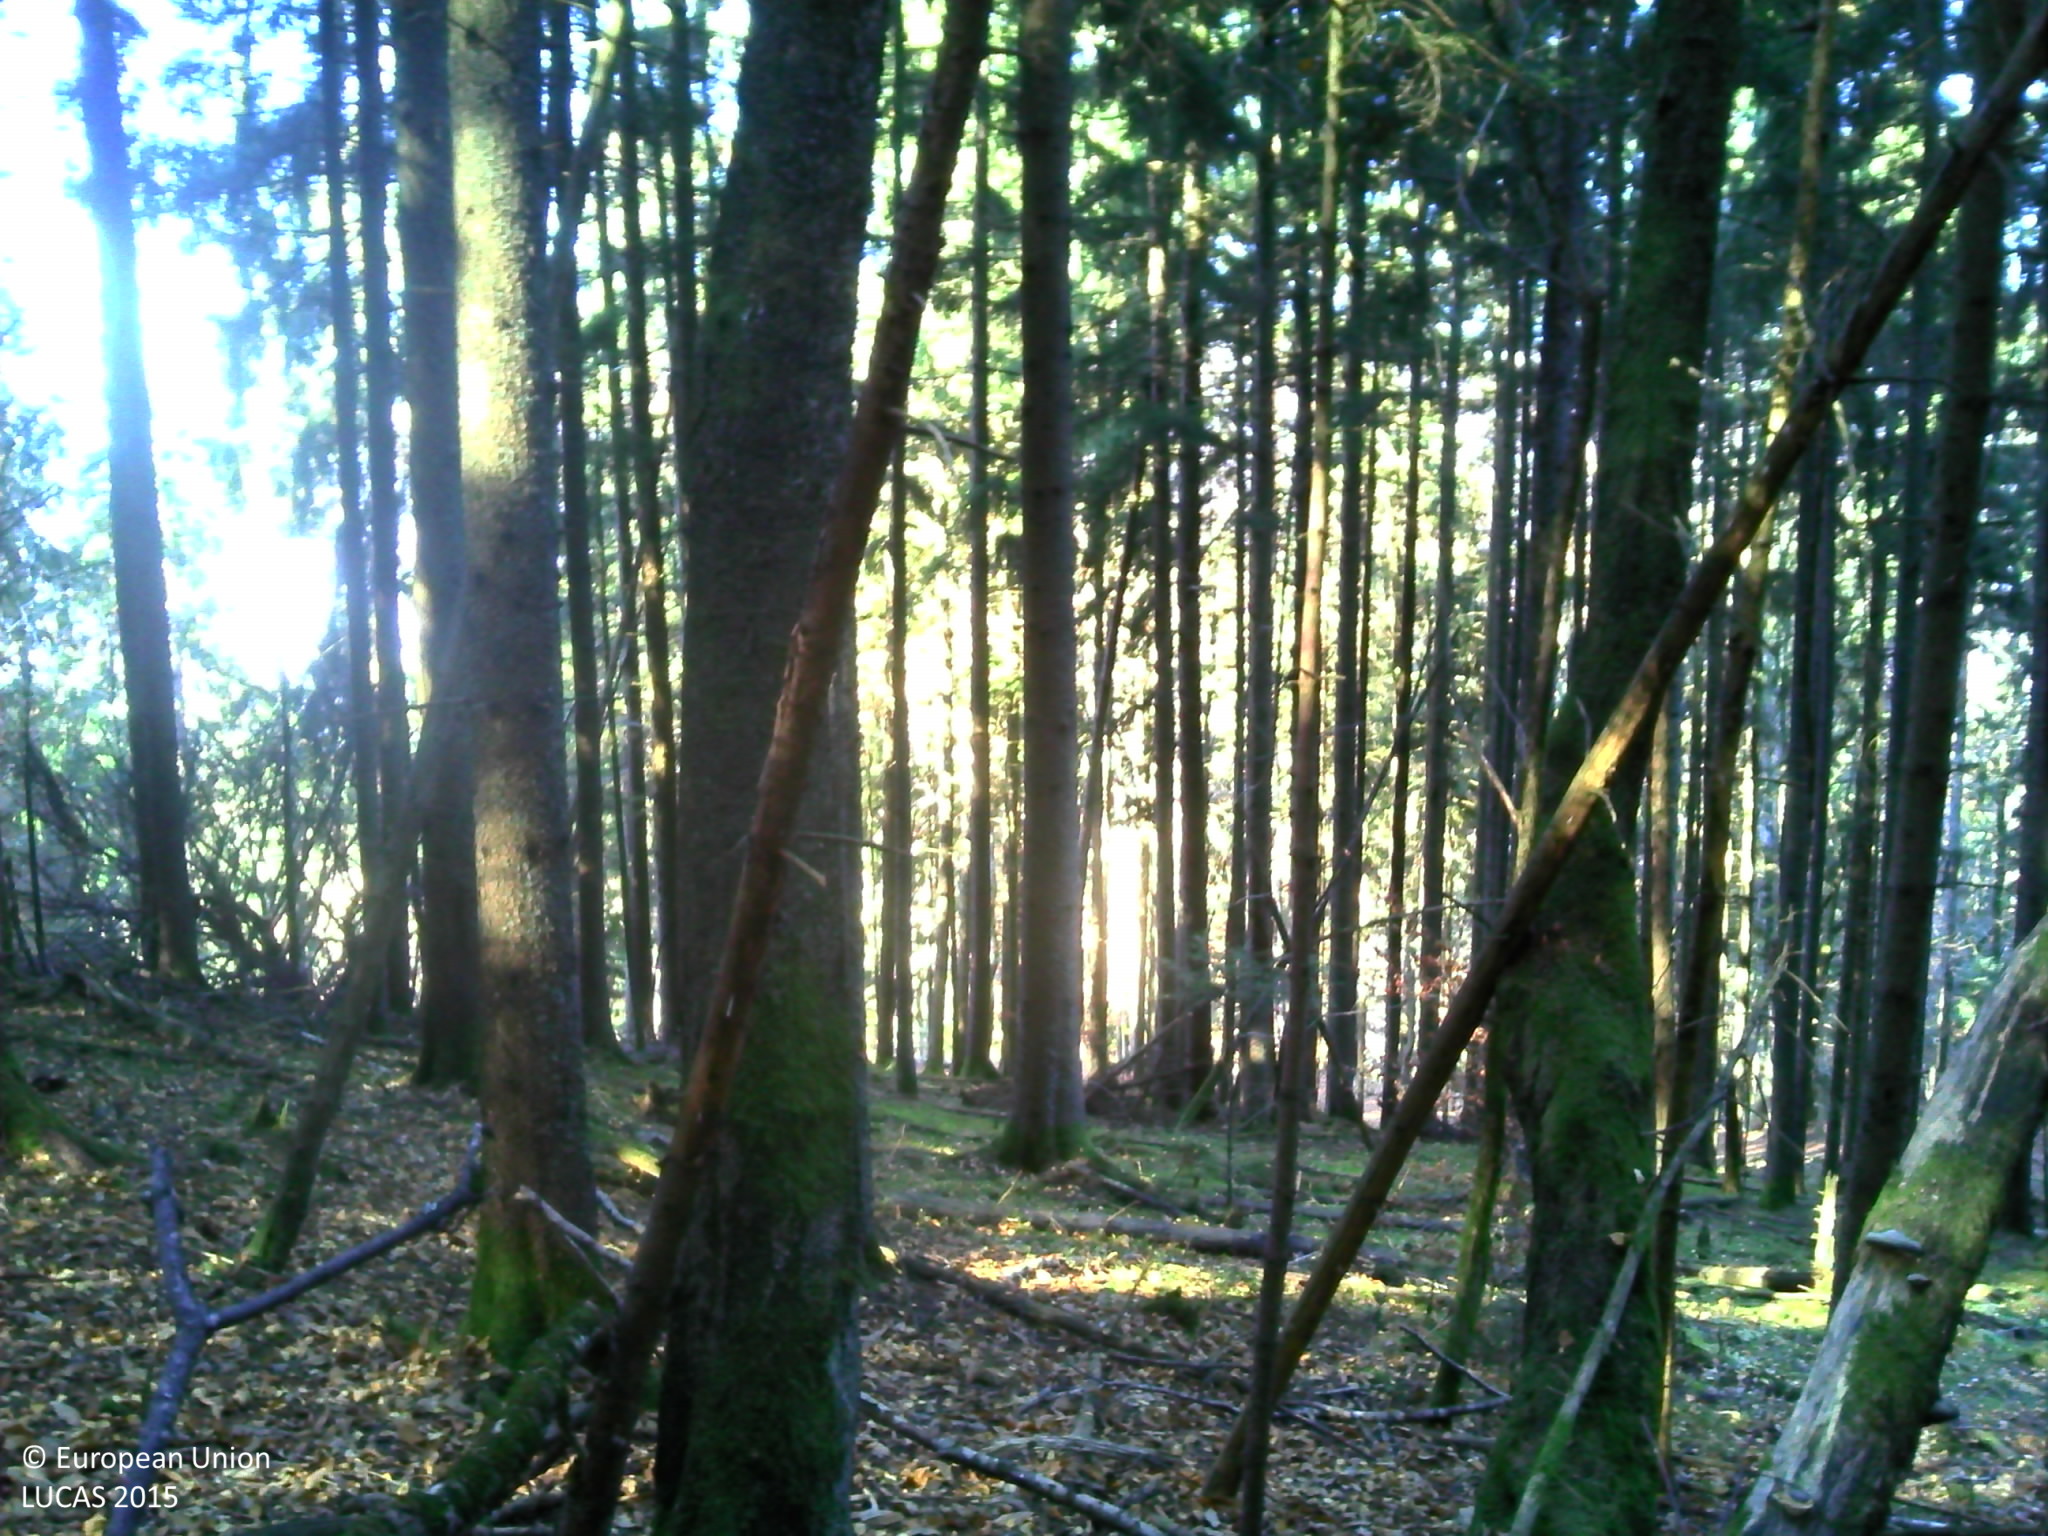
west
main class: Woodland
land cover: Spruce dominated coniferous woodland
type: hemiboreal forest and nemoral coniferous forest and mixed broadleaved-coniferous forest
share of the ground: > 75 %
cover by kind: coniferous forest trees 75 %, broadleaved forest trees 15 %, unconsolidated bare surface 10 %
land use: Forestry
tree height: > 5 m
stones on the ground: < 10 %
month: November
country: FR
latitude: 45.6037
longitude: 6.3504
